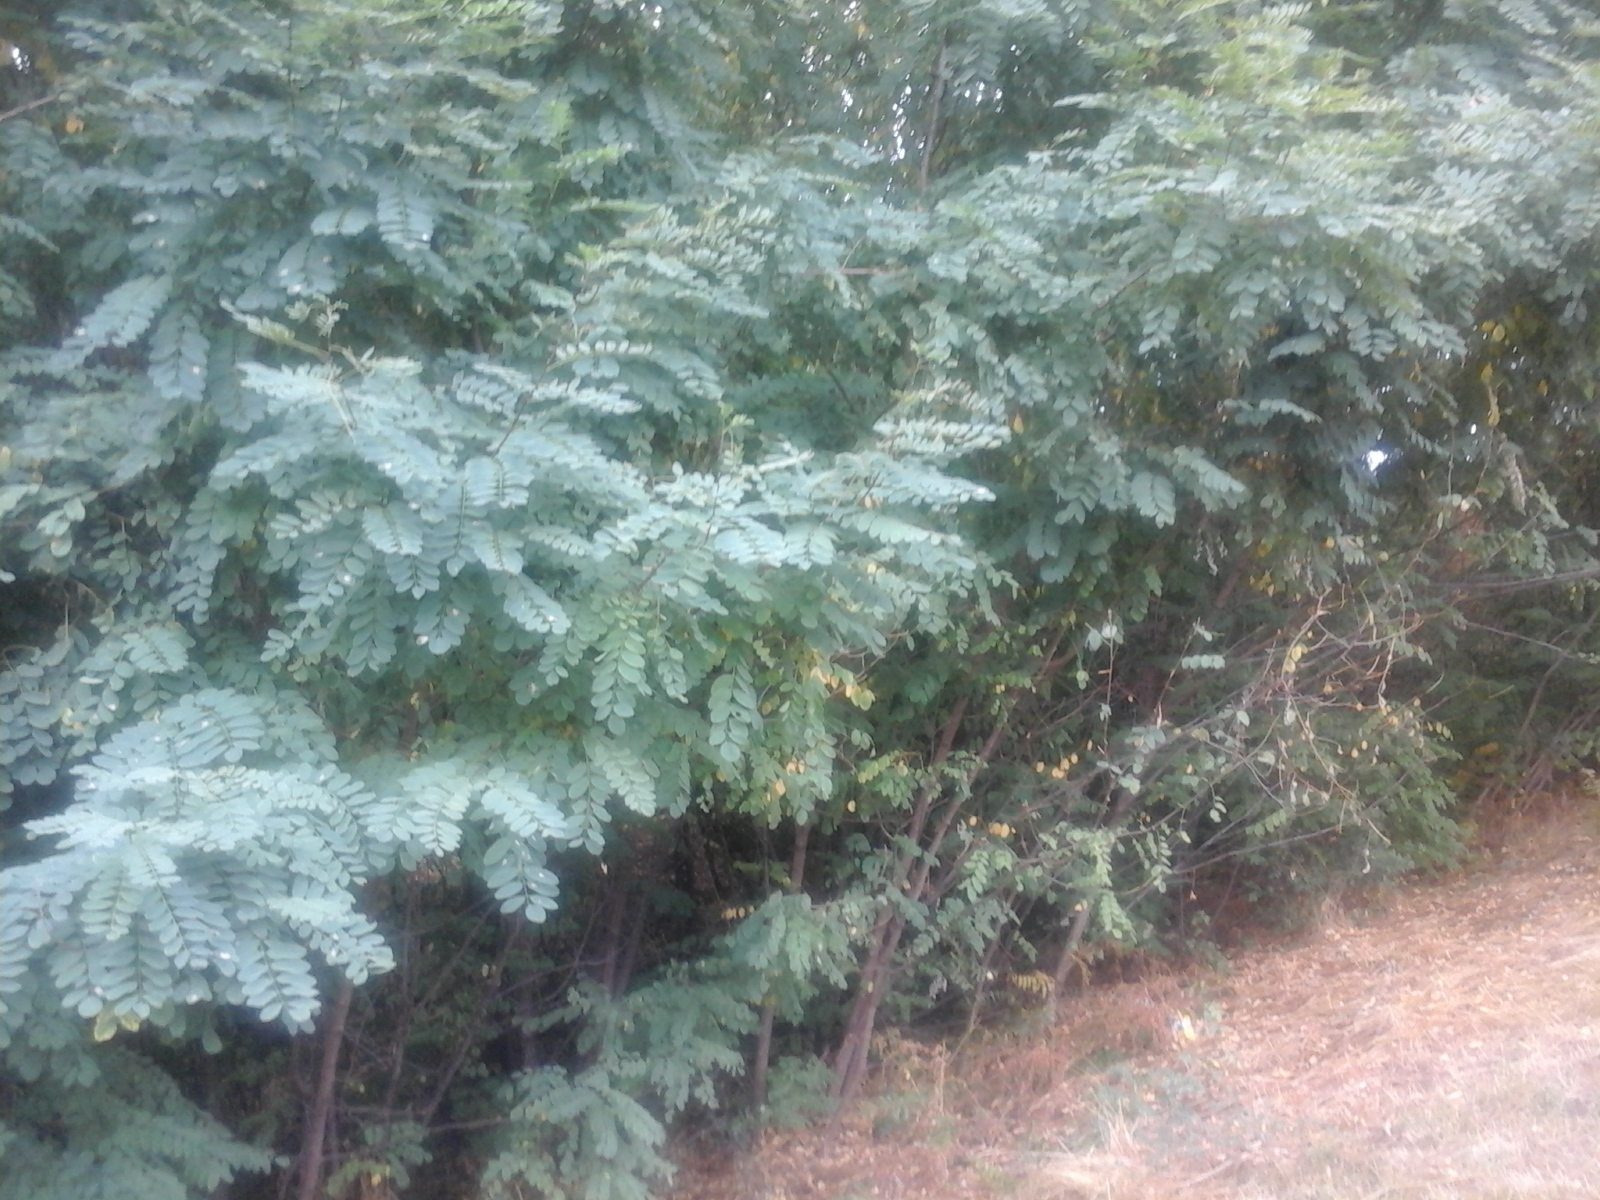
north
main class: Woodland
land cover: Broadleaved woodland
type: exotic forest
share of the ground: > 75 %
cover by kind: broadleaved forest trees 100 %
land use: Forestry
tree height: > 5 m
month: August
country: RO
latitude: 44.9873
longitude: 22.7153
